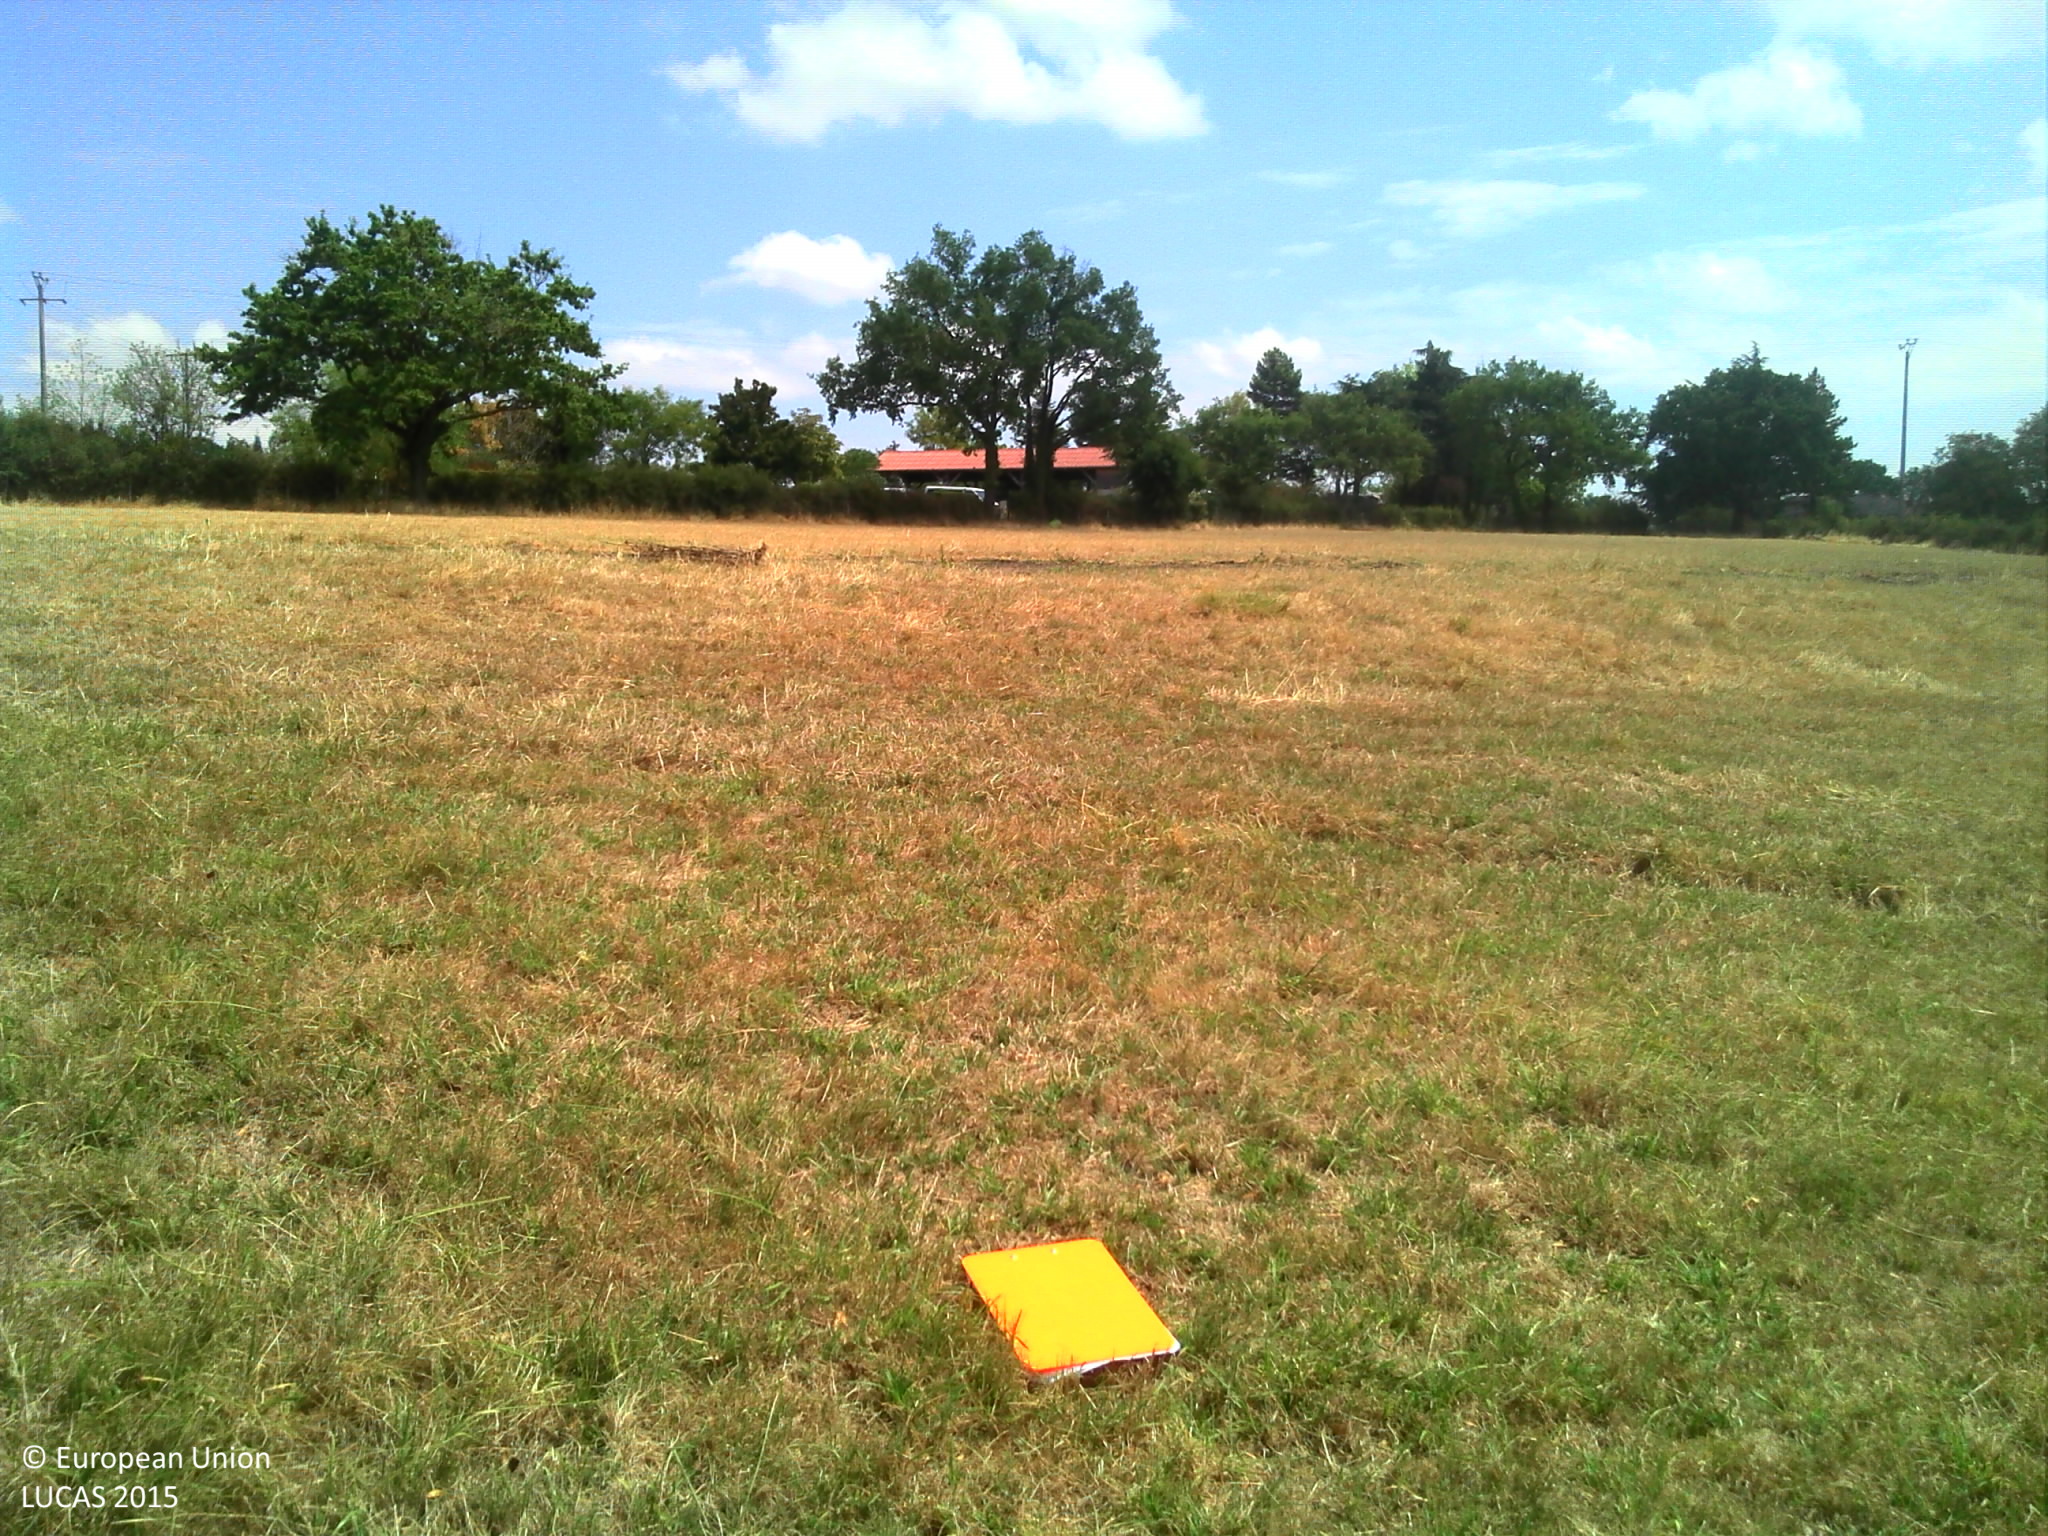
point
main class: Grassland
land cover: Grassland without tree/shrub cover
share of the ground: > 75 %
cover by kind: herbaceous plants 100 %
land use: Agriculture (excluding fallow land and kitchen gardens)
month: August
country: FR
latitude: 45.7682
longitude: 4.6927
